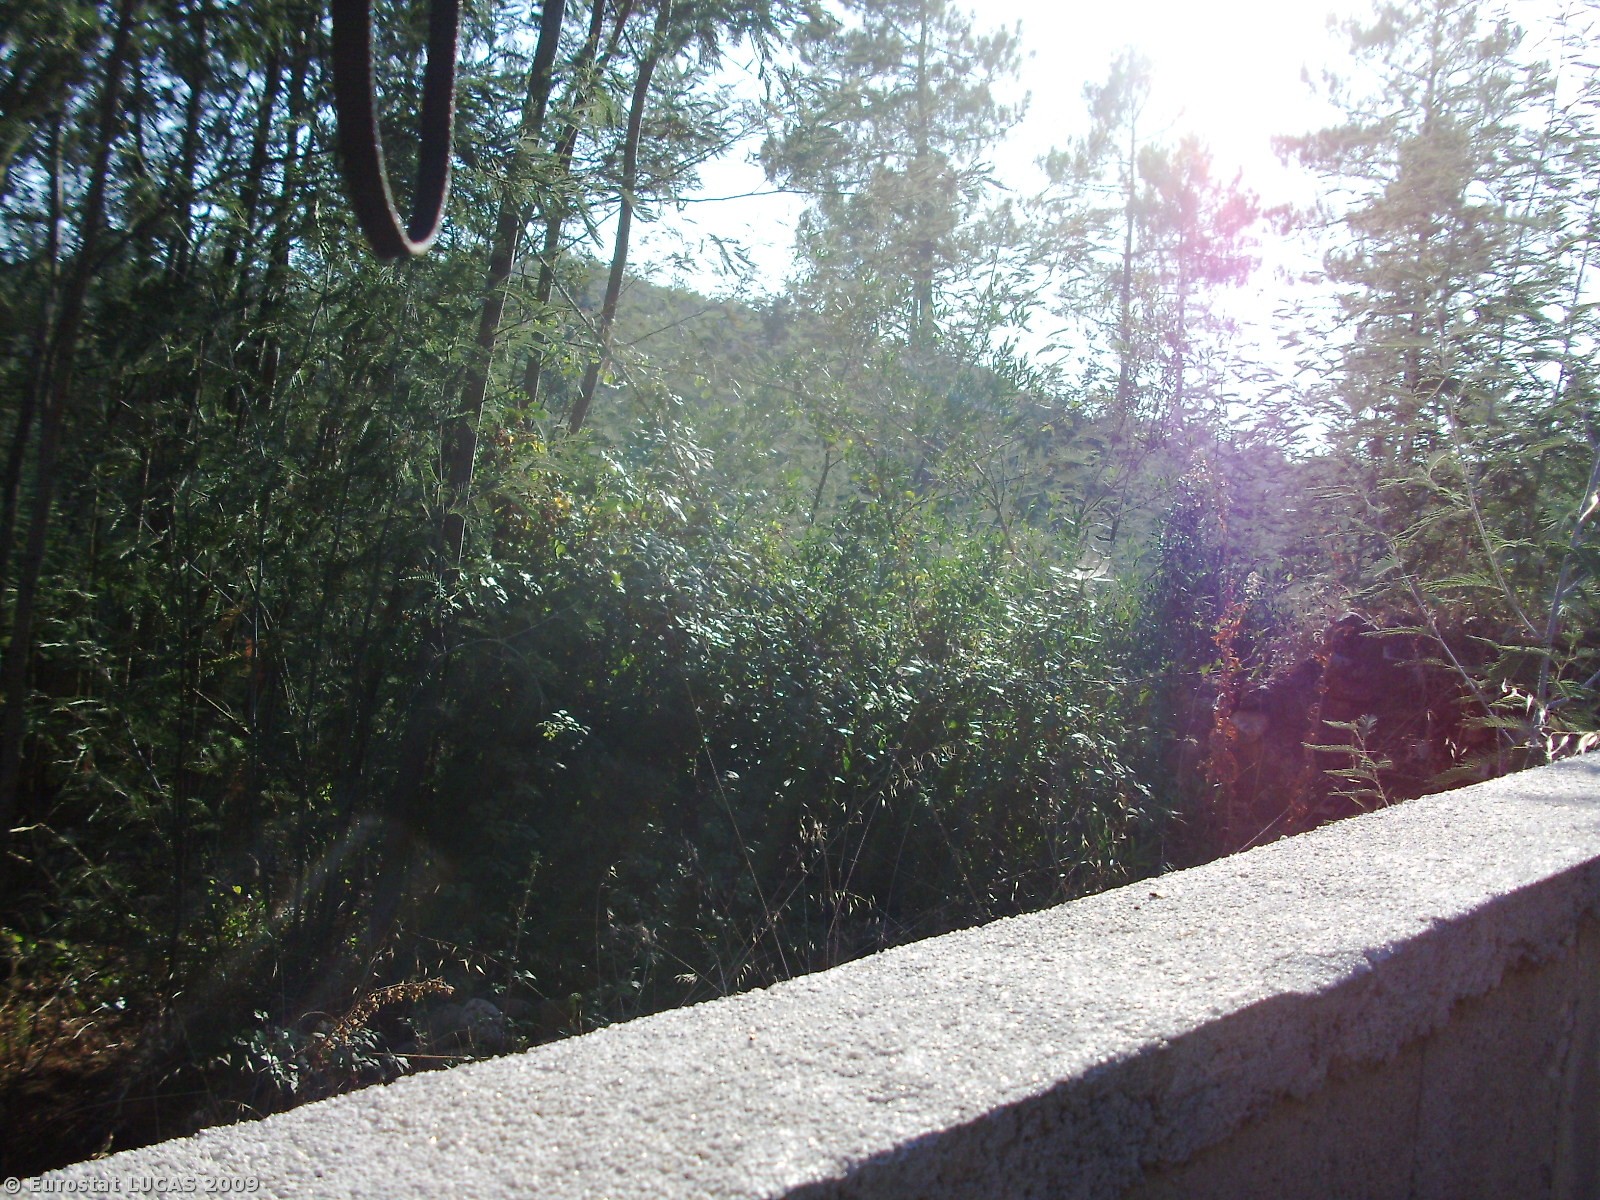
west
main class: Woodland
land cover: Broadleaved woodland
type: thermophilous deciduous forest
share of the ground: > 75 %
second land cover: Shrubland with sparse tree cover
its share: 10 - 25 %
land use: Forestry
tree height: > 5 m
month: August
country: PT
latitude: 40.1544
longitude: -8.2146
